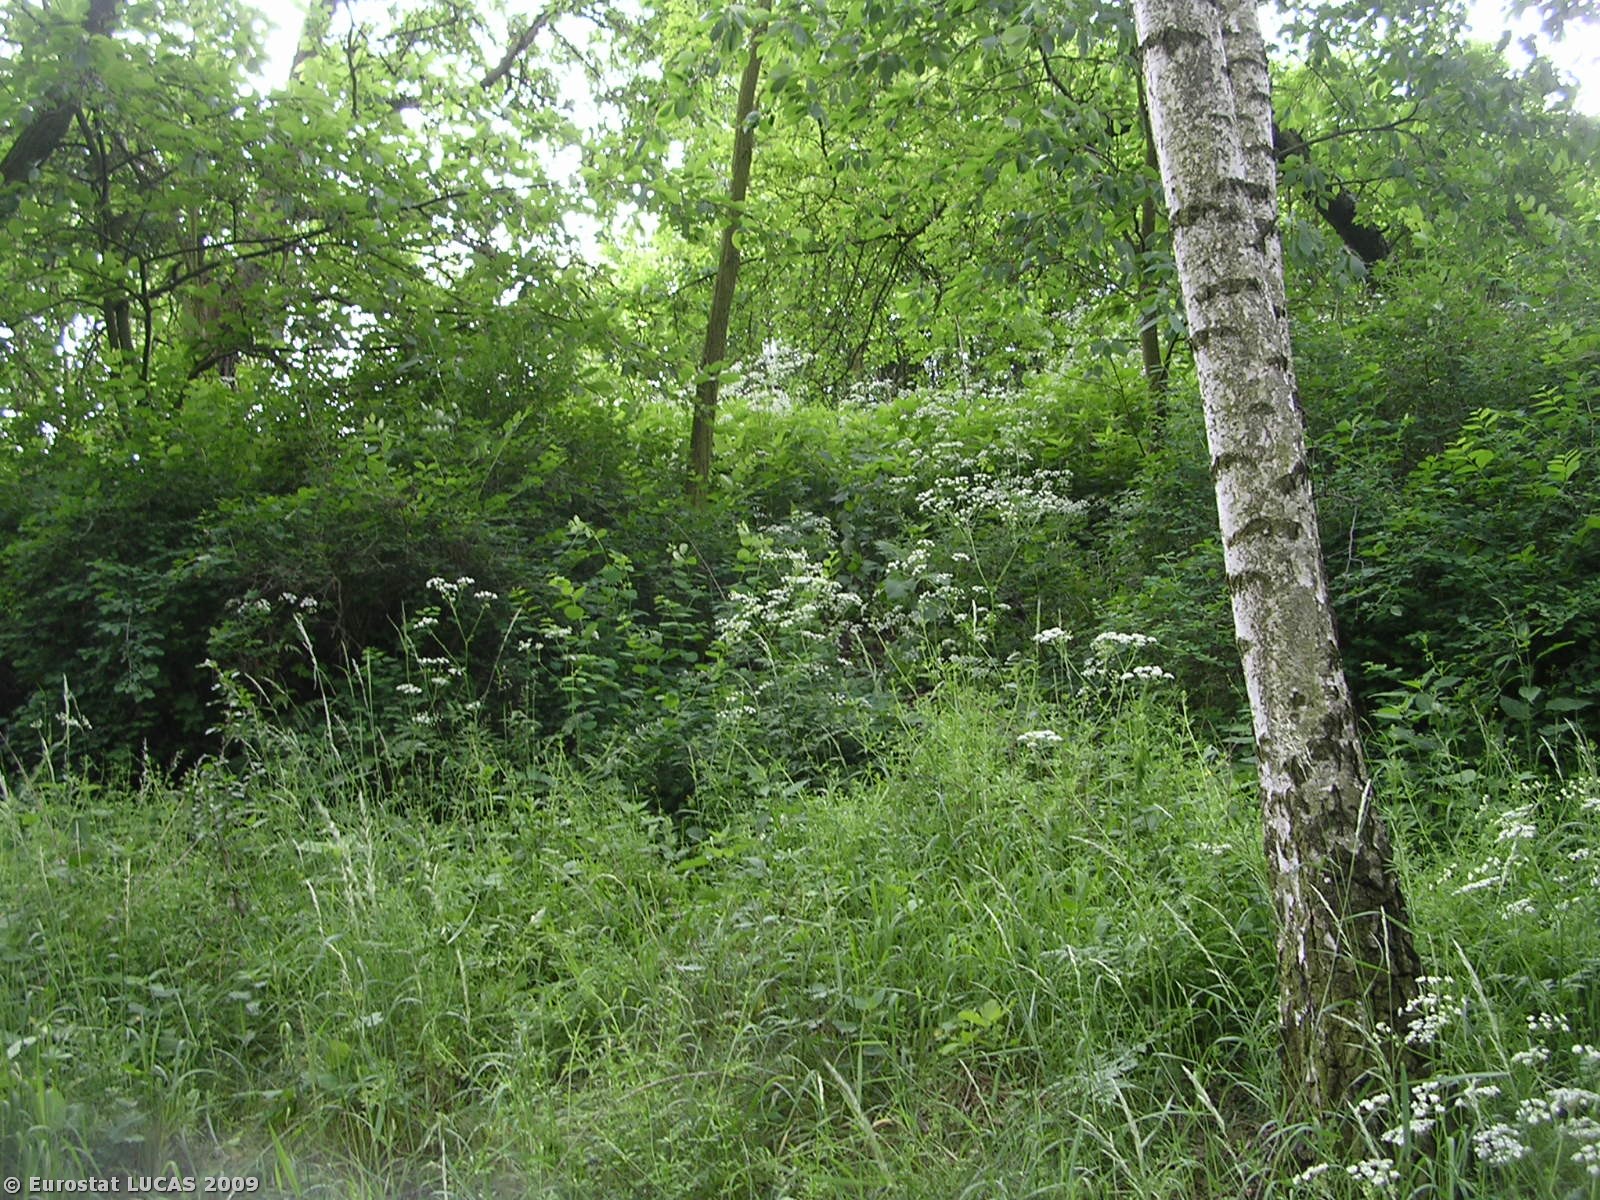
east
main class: Woodland
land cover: Broadleaved woodland
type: non-riverine alder, birch or aspen forest
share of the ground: 50 - 75 %
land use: Forestry
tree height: > 5 m
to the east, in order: Broadleaved woodland; Common wheat; Grassland with sparse tree/shrub cover; Cherry fruit; Tracks; Cherry fruit; Grassland with sparse tree/shrub cover
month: May
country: CZ
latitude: 50.1763
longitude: 14.2721
